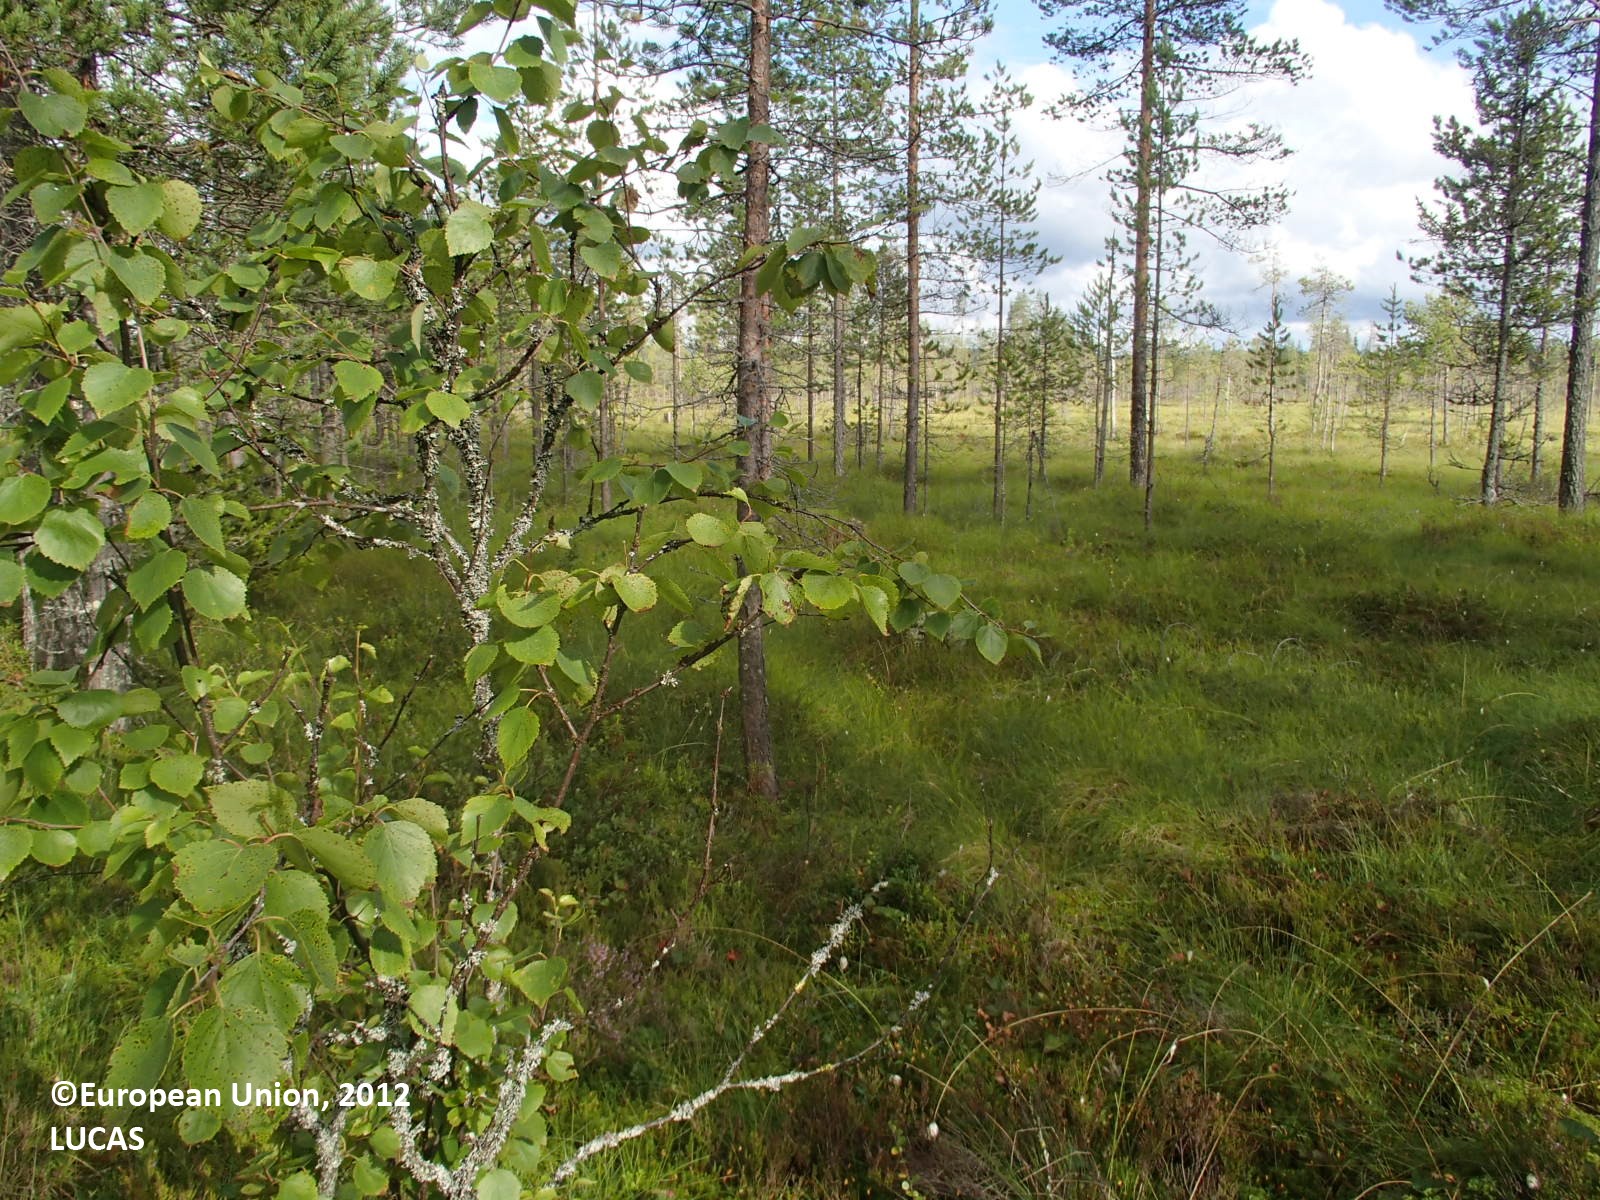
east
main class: Woodland
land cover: Pine dominated mixed woodland
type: boreal forest
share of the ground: 25 - 50 %
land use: Forestry
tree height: > 5 m
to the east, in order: Pine dominated mixed woodland; Tracks; Pine dominated coniferous woodland; Spontaneously vegetated surfaces; Pine dominated coniferous woodland; Spontaneously vegetated surfaces
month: August
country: FI
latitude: 63.8384
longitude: 28.1641
